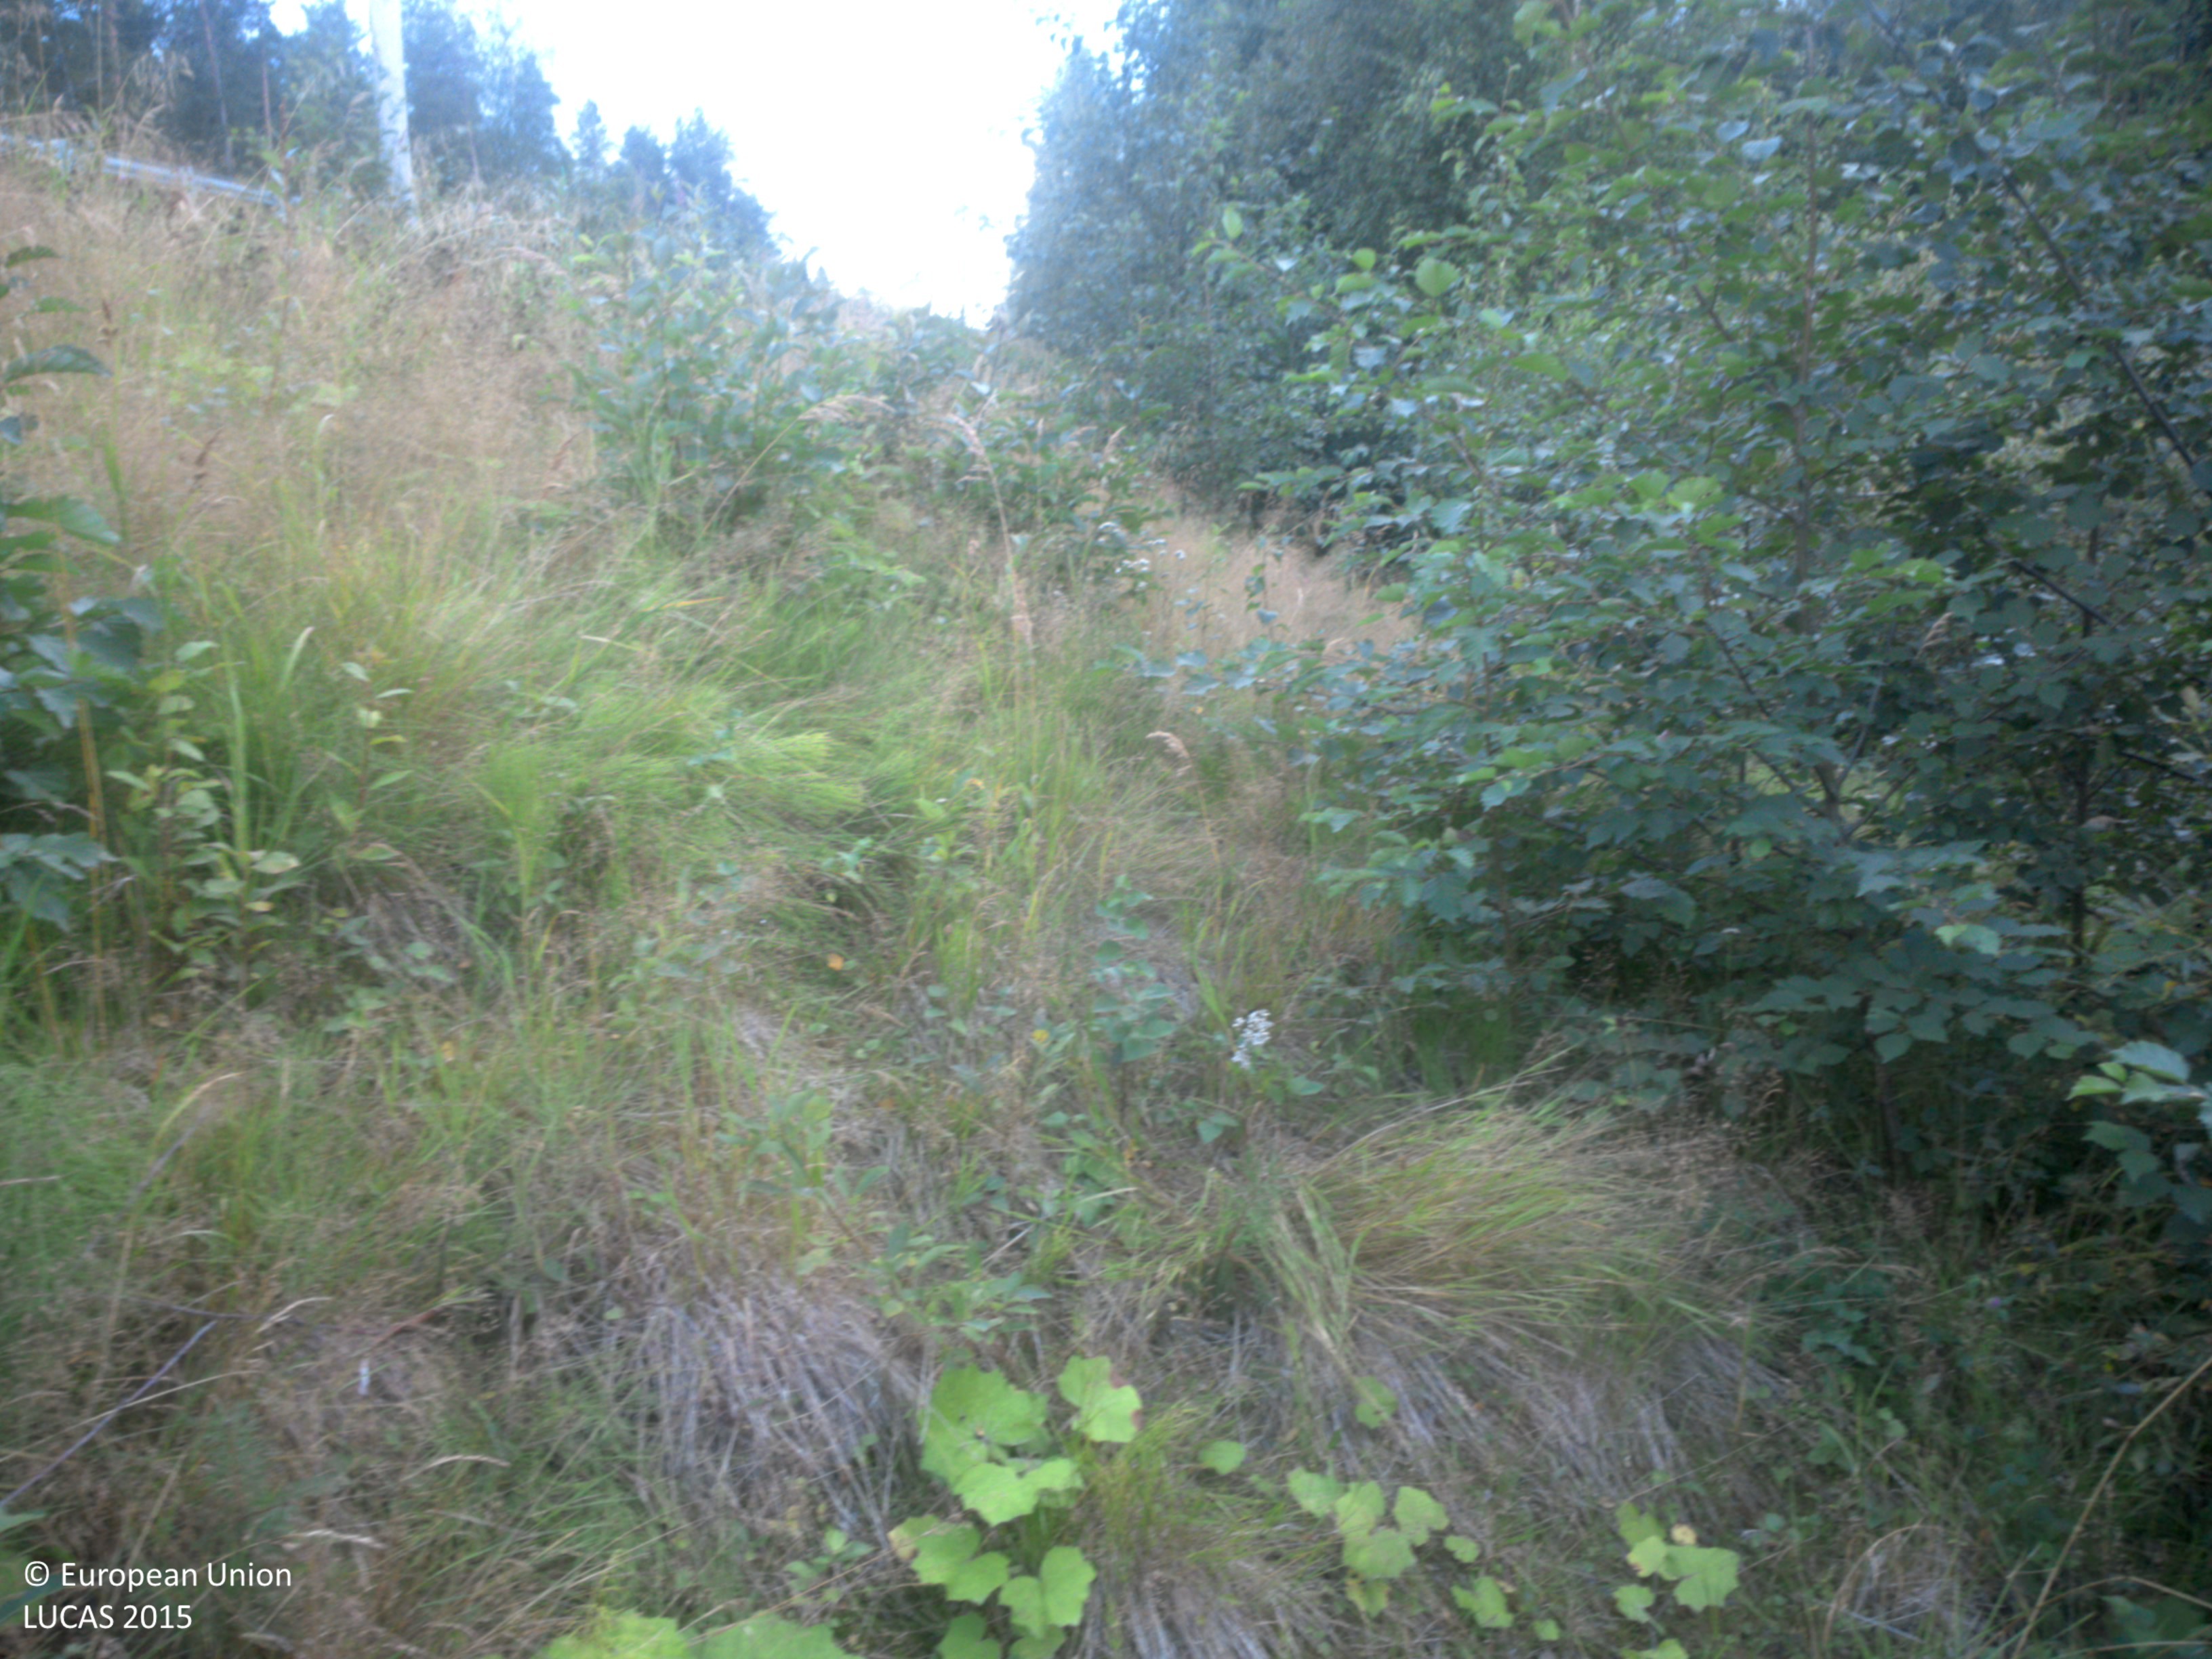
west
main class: Woodland
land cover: Broadleaved woodland
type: hemiboreal forest and nemoral coniferous forest and mixed broadleaved-coniferous forest
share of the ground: 50 - 75 %
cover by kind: broadleaved forest trees 50 %, herbaceous plants 45 %, coniferous forest trees 5 %
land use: Semi-natural and natural areas not in use
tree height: < 5 m
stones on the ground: < 10 %
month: August
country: SE
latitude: 63.8625
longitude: 20.0104
